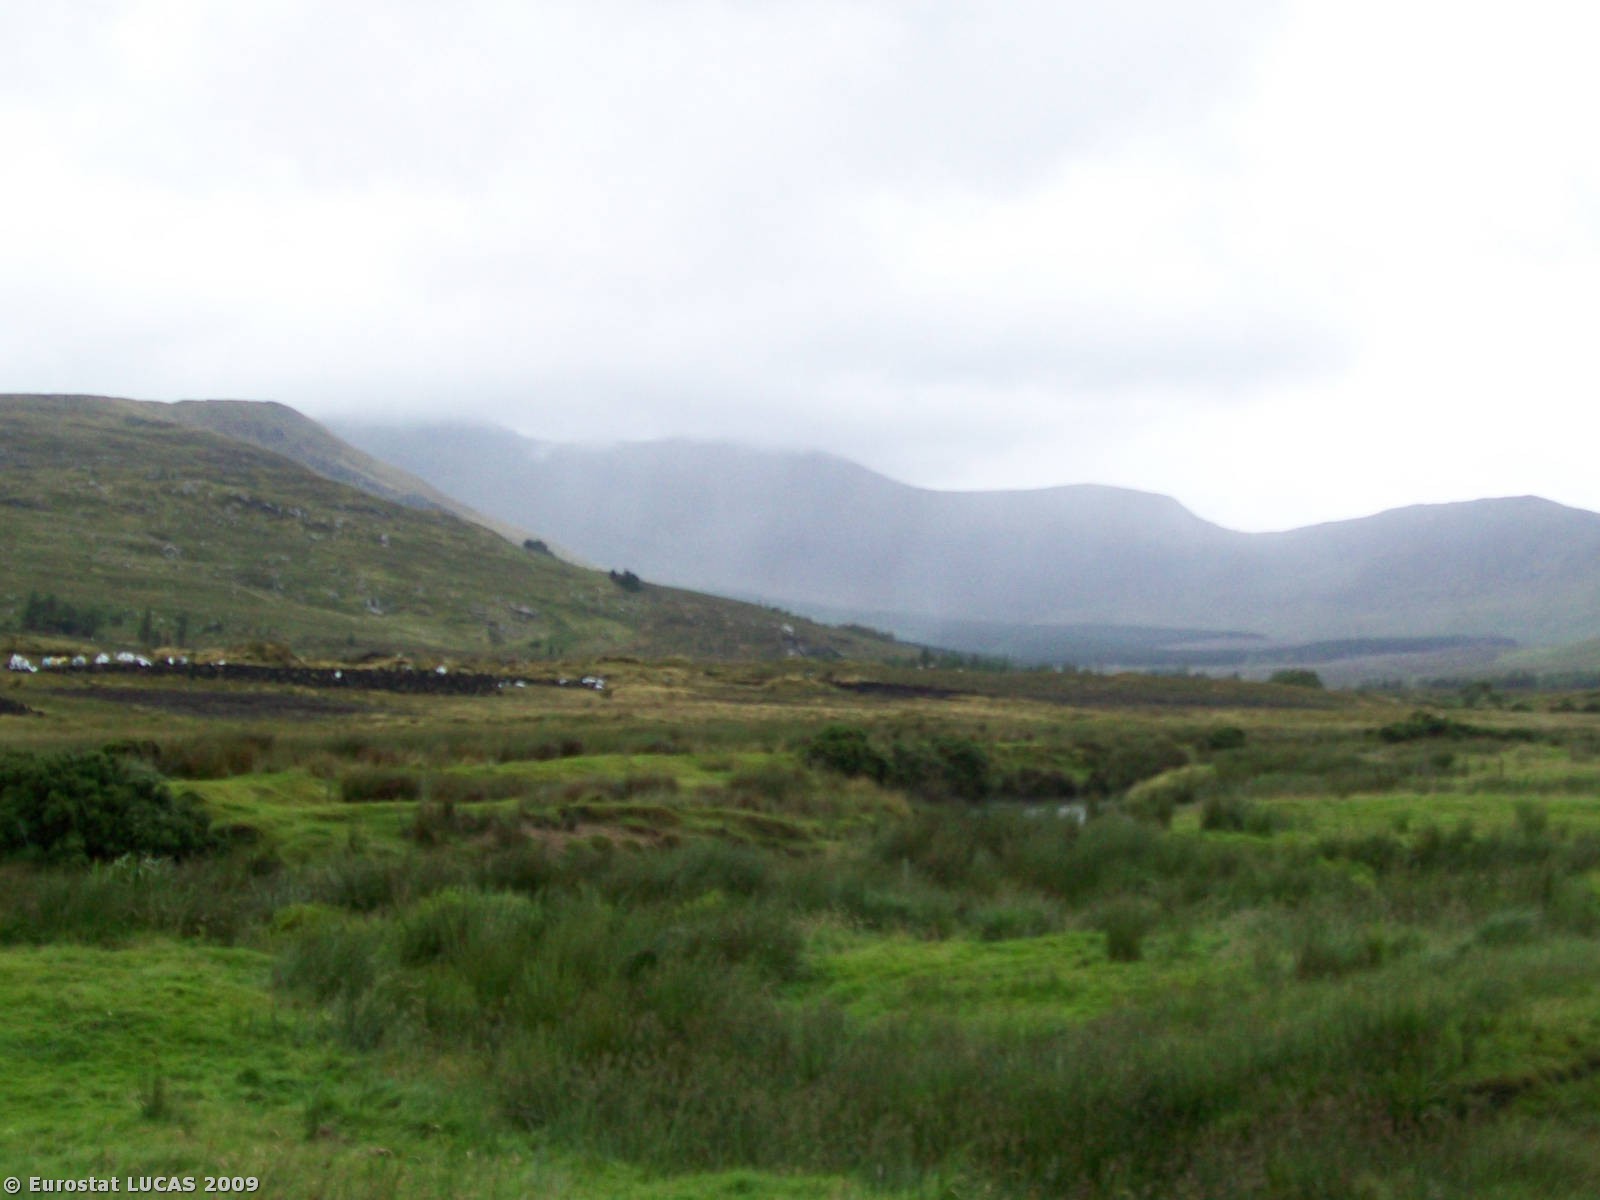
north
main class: Wetlands
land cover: Peatbogs
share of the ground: > 75 %
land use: Nature reserves
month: July
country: IE
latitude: 53.9192
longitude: -9.6516
